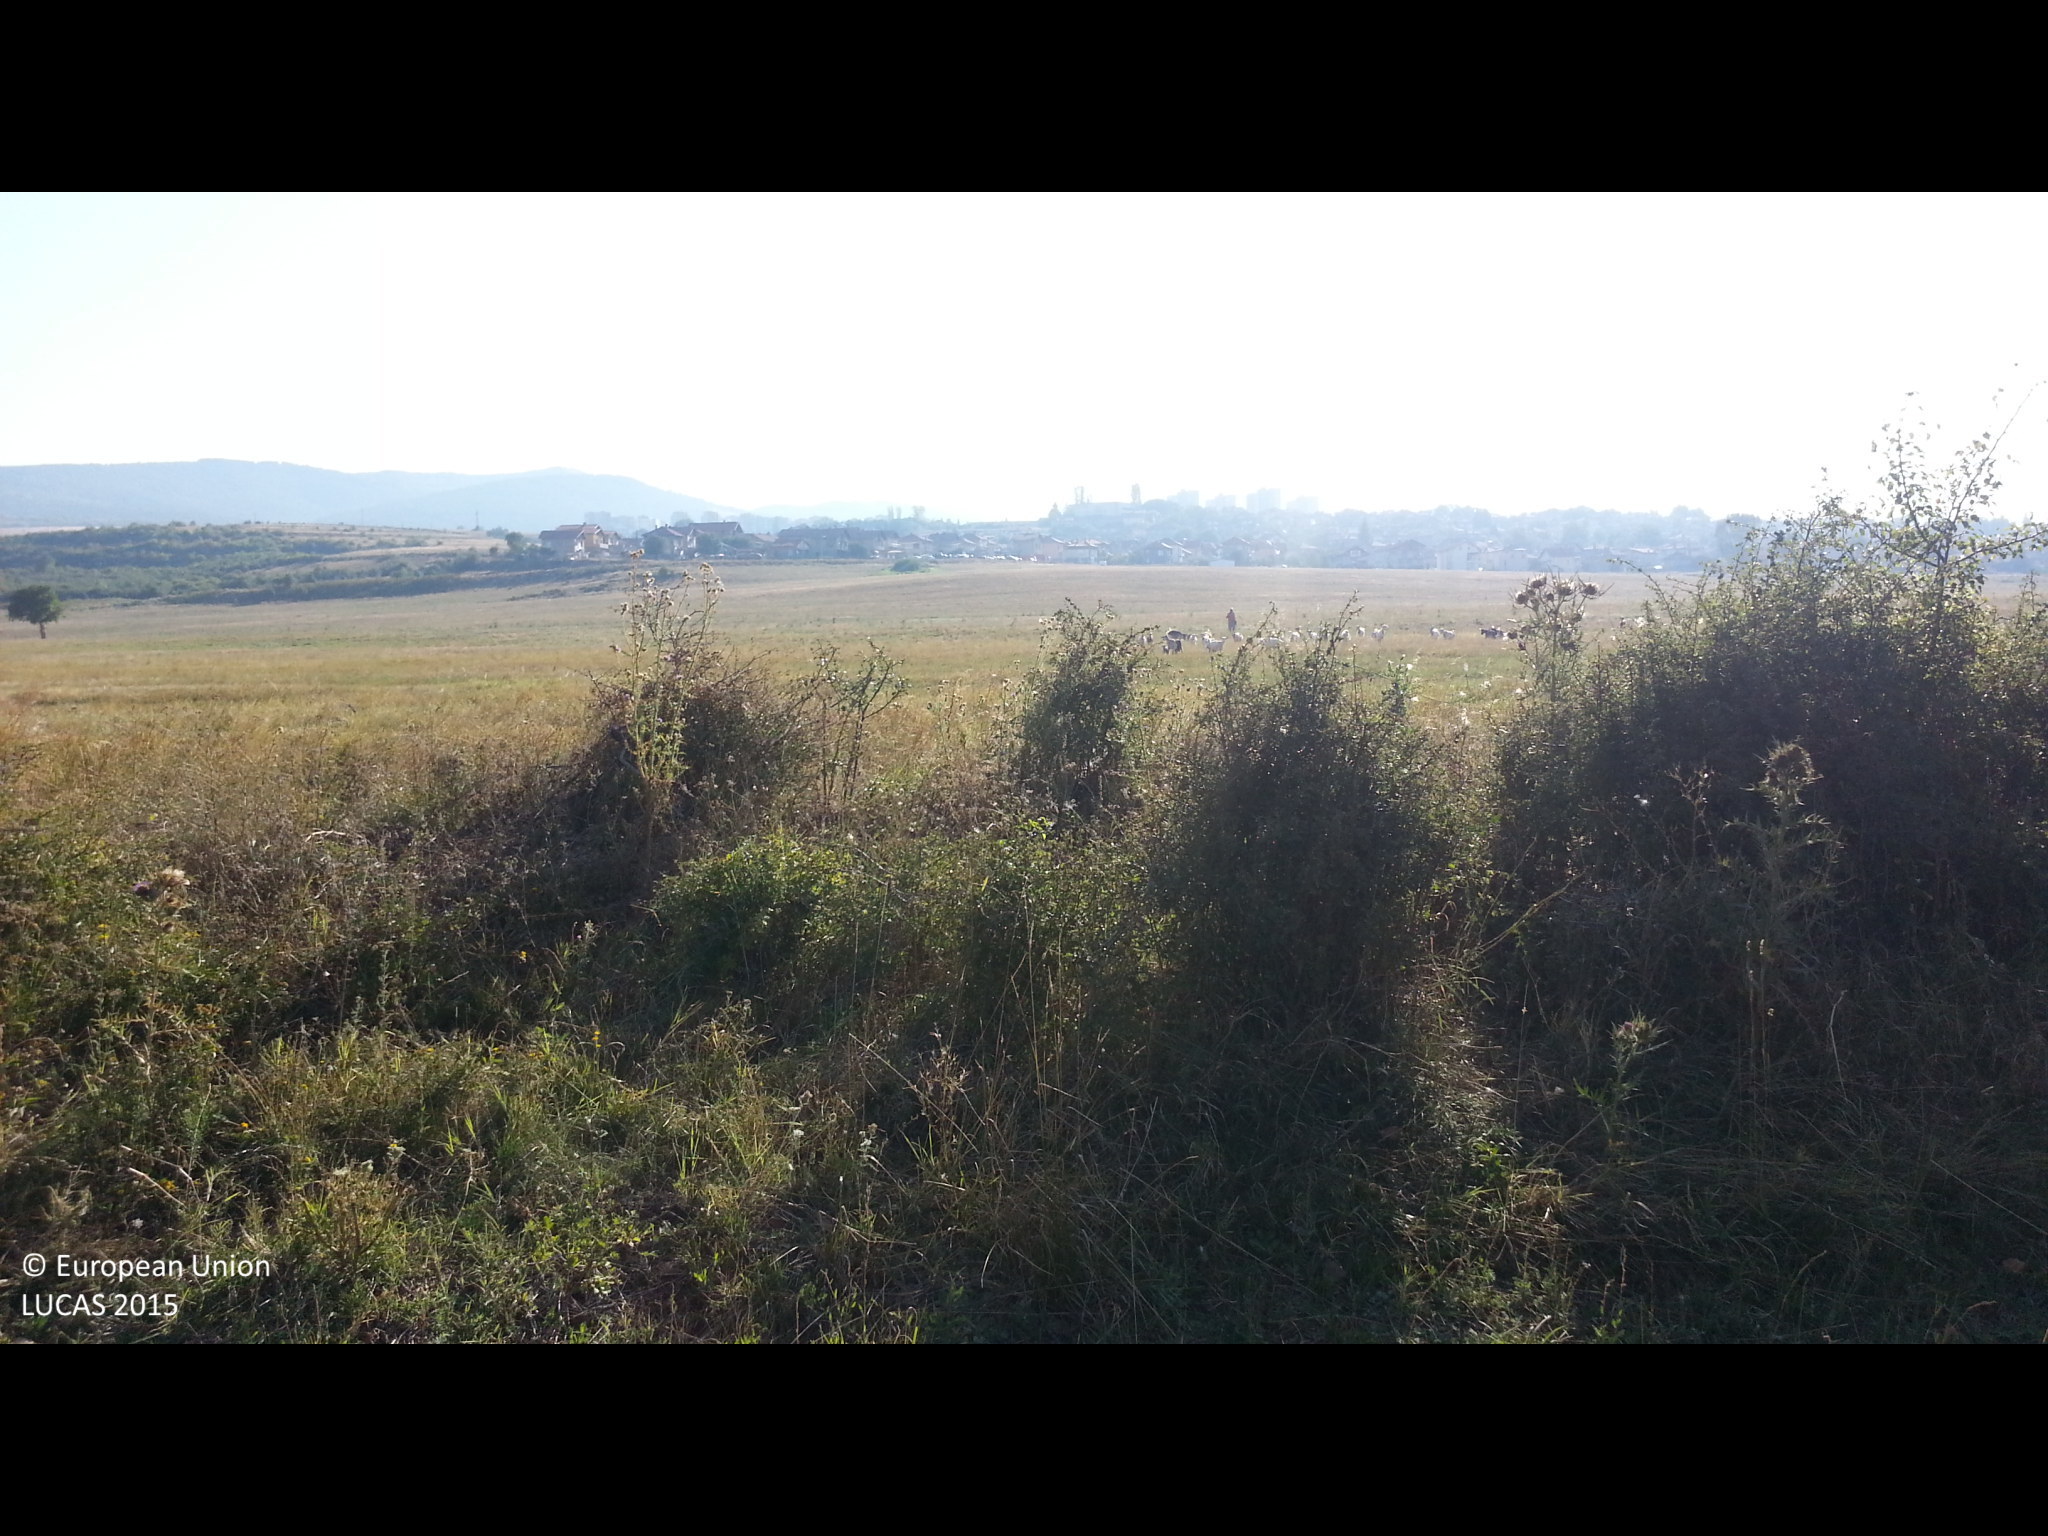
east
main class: Grassland
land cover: Grassland with sparse tree/shrub cover
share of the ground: > 75 %
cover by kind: herbaceous plants 95 %, broadleaved forest trees 5 %
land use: Agriculture (excluding fallow land and kitchen gardens)
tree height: > 5 m
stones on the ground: < 10 %
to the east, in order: Grassland with sparse tree/shrub cover; Grassland without tree/shrub cover; Tracks; Electric lines; Grassland without tree/shrub cover
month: August
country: BG
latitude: 42.5496
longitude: 22.9487
